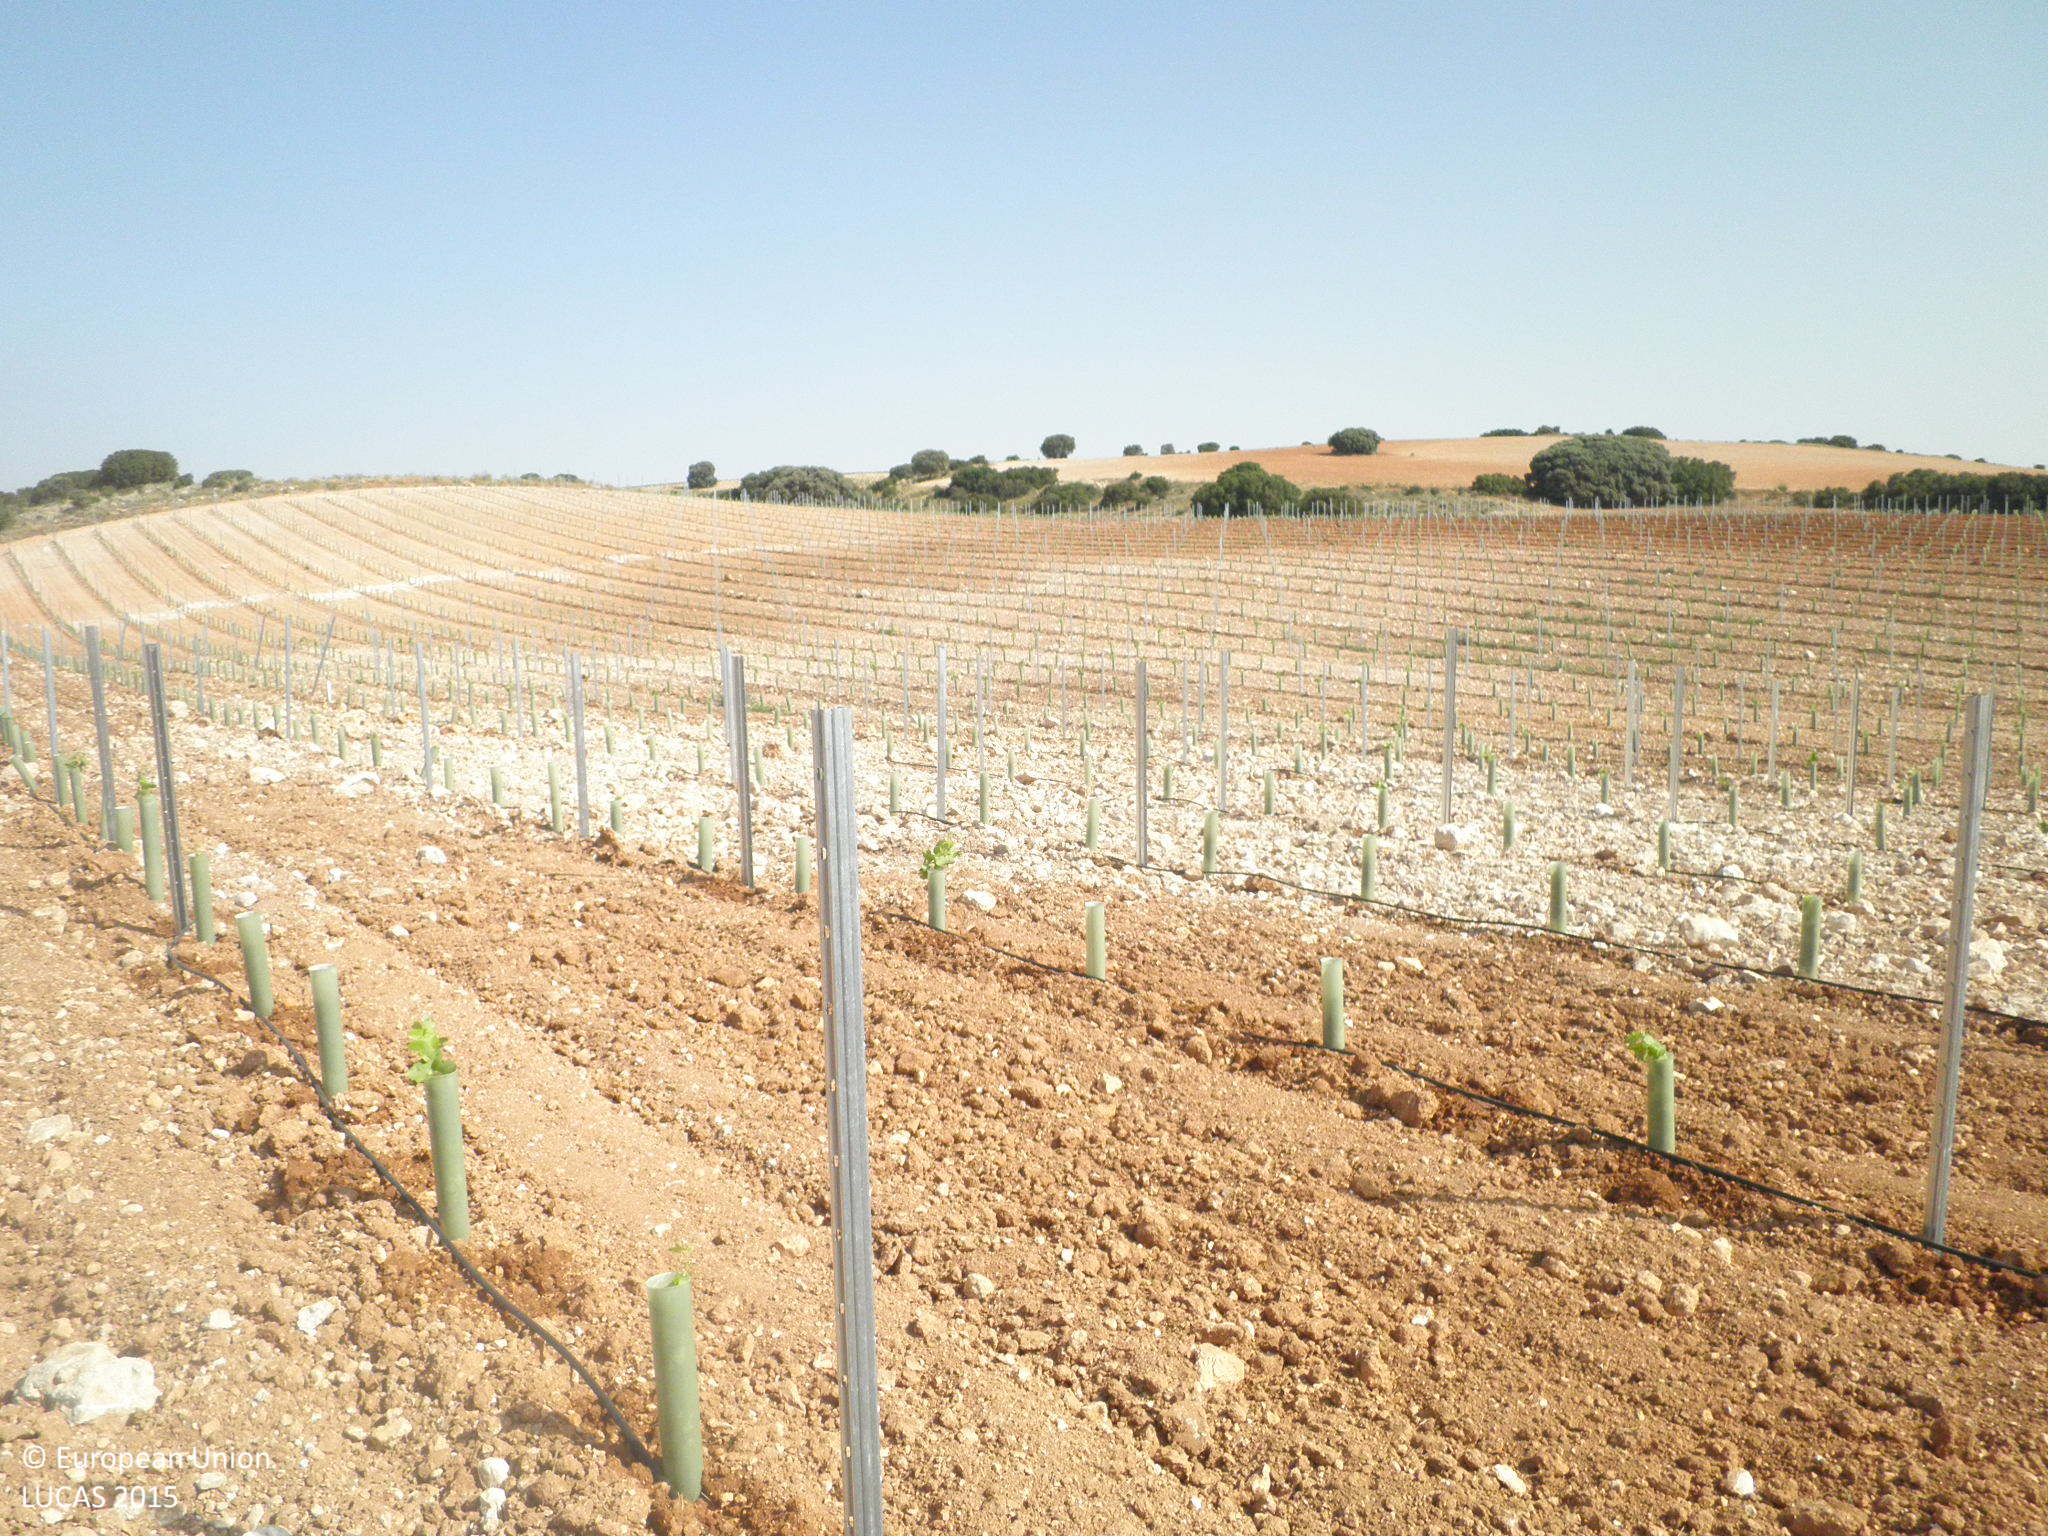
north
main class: Cropland
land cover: Vineyards
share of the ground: < 10 %
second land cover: Other bare soil
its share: > 75 %
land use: Agriculture (excluding fallow land and kitchen gardens)
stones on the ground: 10 - 25 %
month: July
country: ES
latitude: 39.6301
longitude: -2.6327
